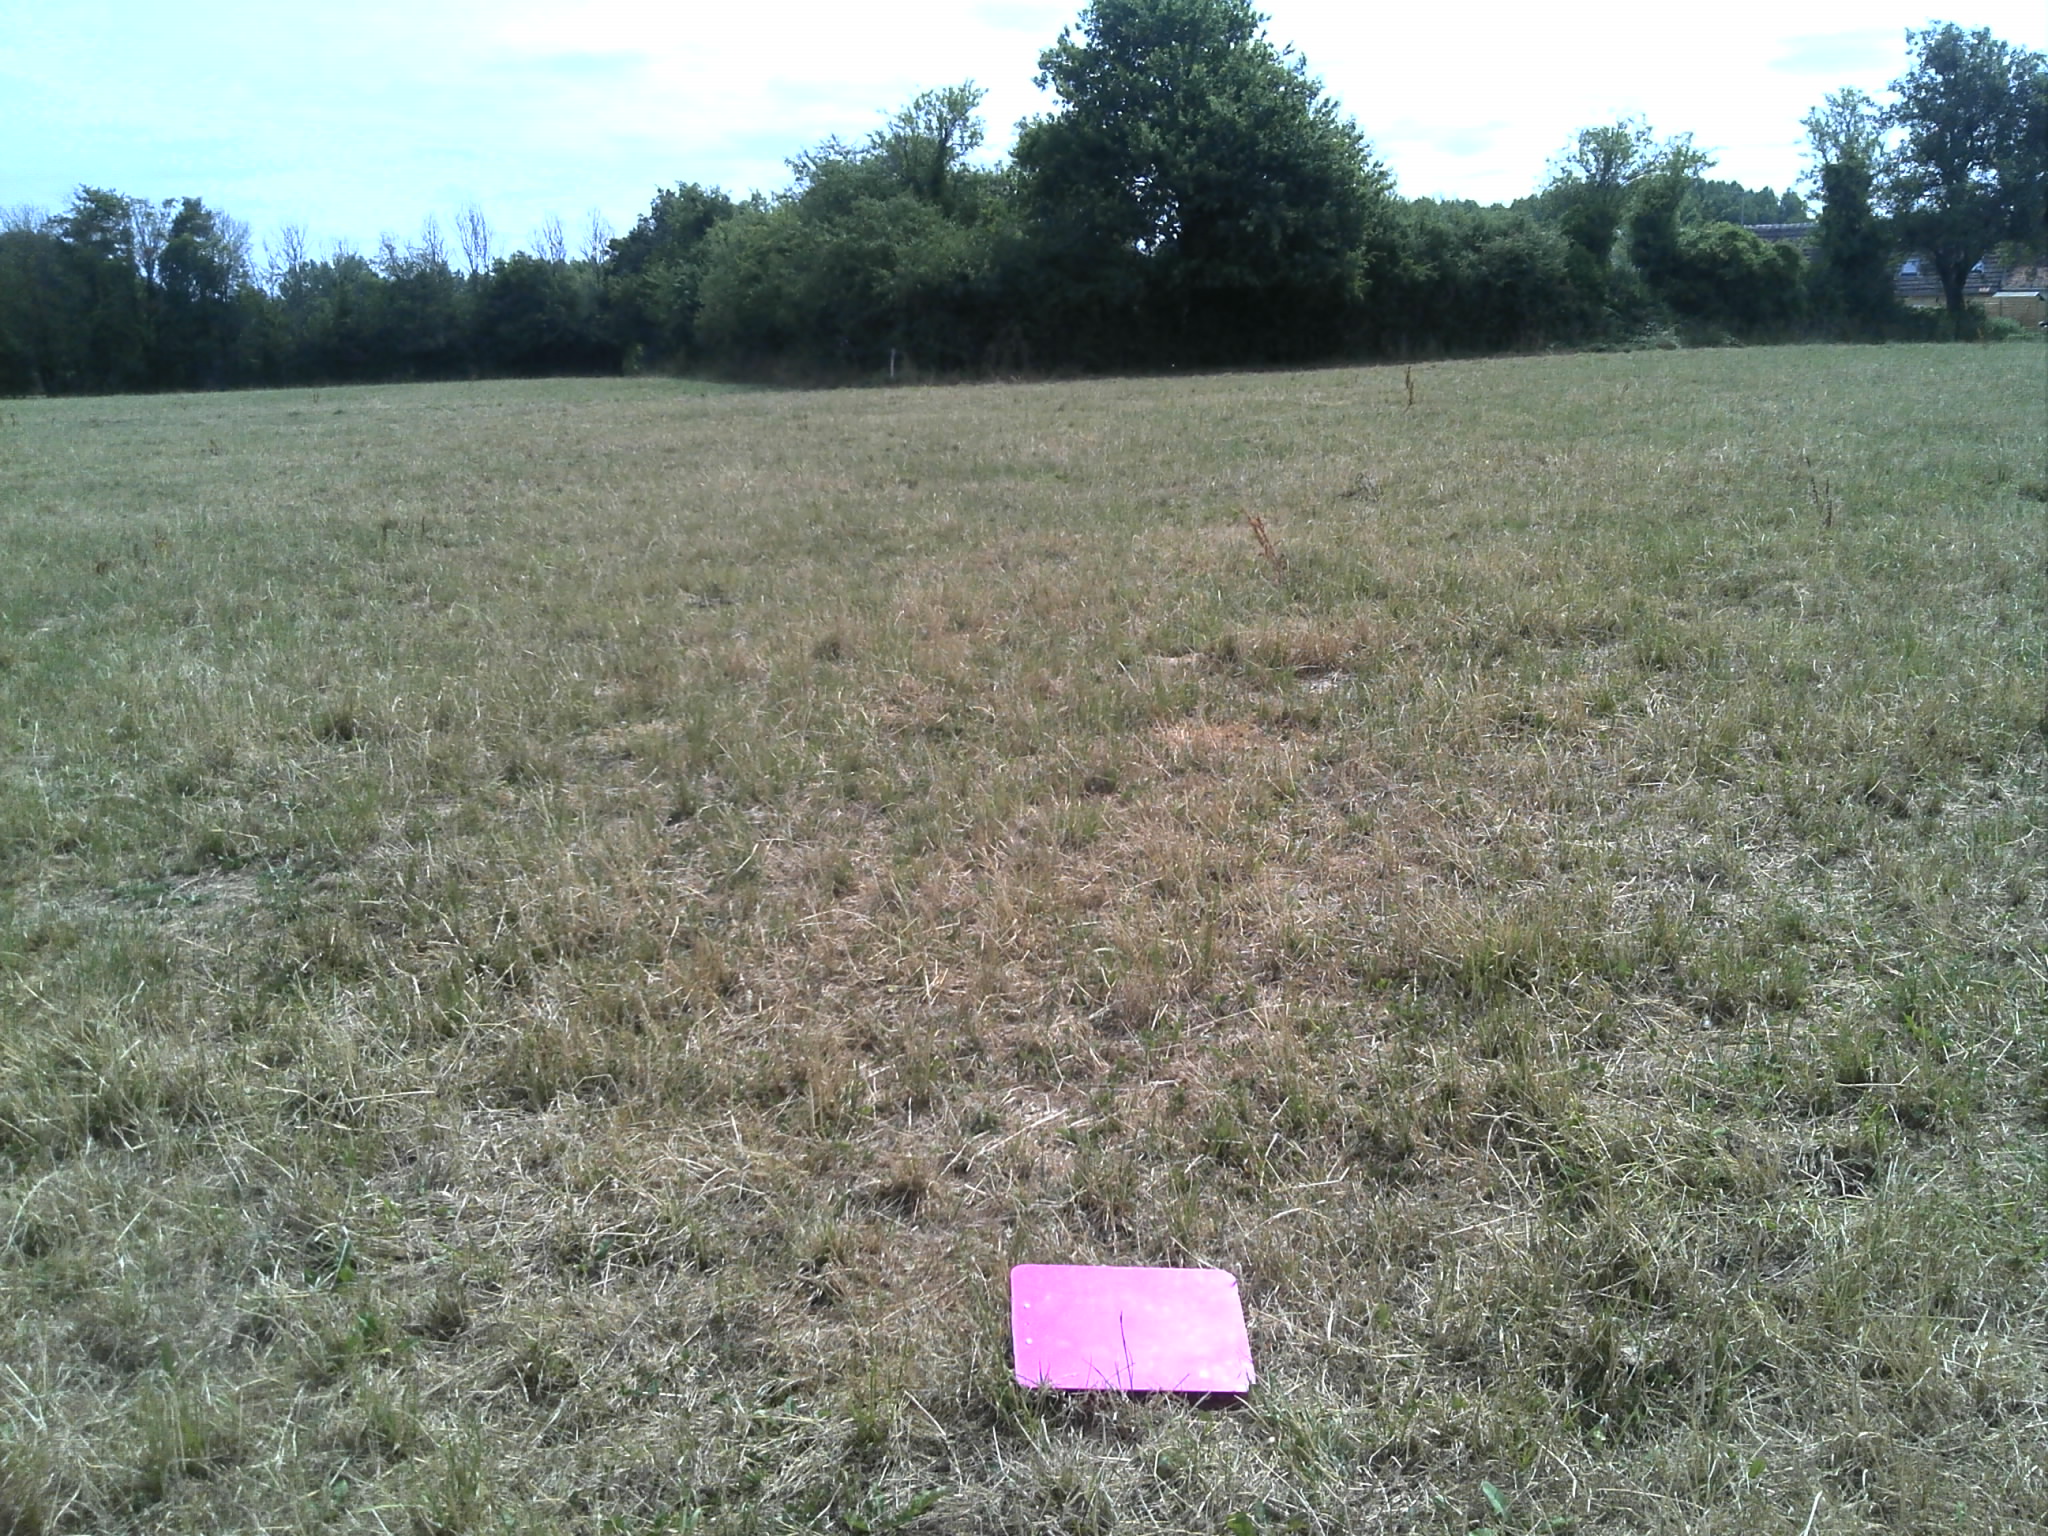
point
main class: Grassland
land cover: Grassland without tree/shrub cover
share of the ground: > 75 %
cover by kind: herbaceous plants 100 %
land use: Agriculture (excluding fallow land and kitchen gardens)
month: July
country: FR
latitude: 46.9411
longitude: 1.1182
